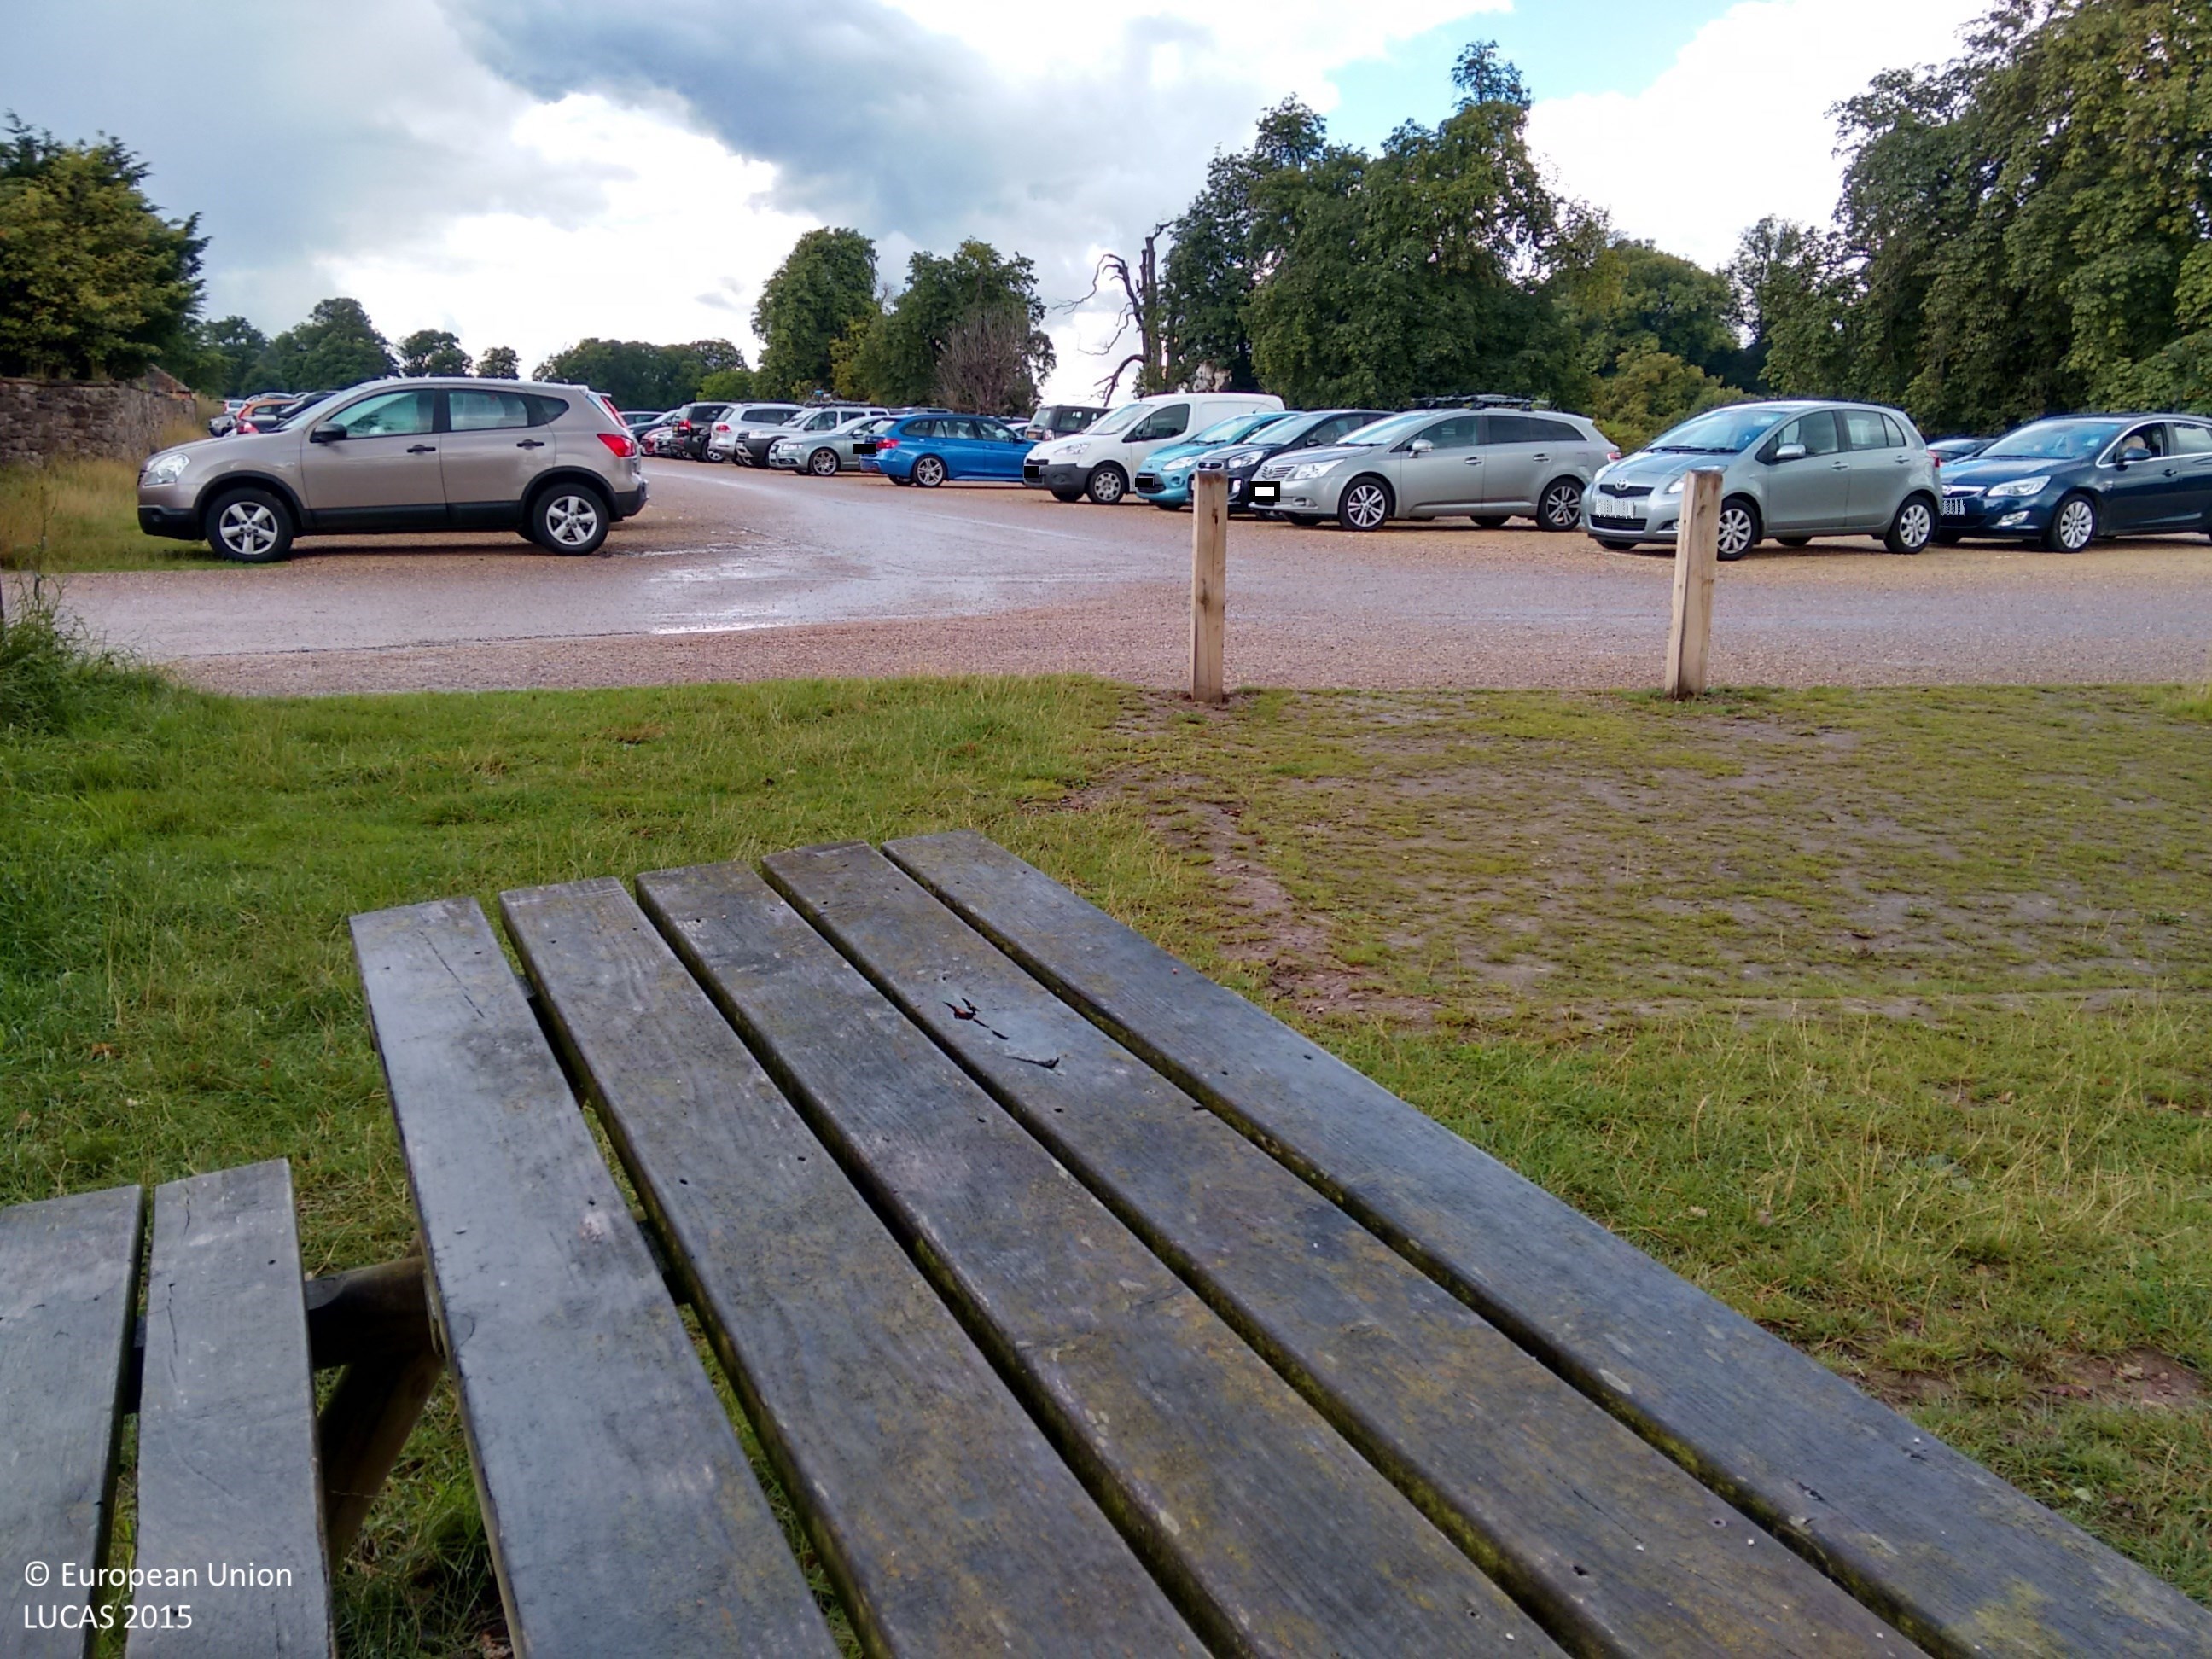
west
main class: Grassland
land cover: Grassland without tree/shrub cover
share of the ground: > 75 %
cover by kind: herbaceous plants 100 %
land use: Agriculture (excluding fallow land and kitchen gardens)
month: September
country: GB
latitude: 52.8017
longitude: -1.4564
